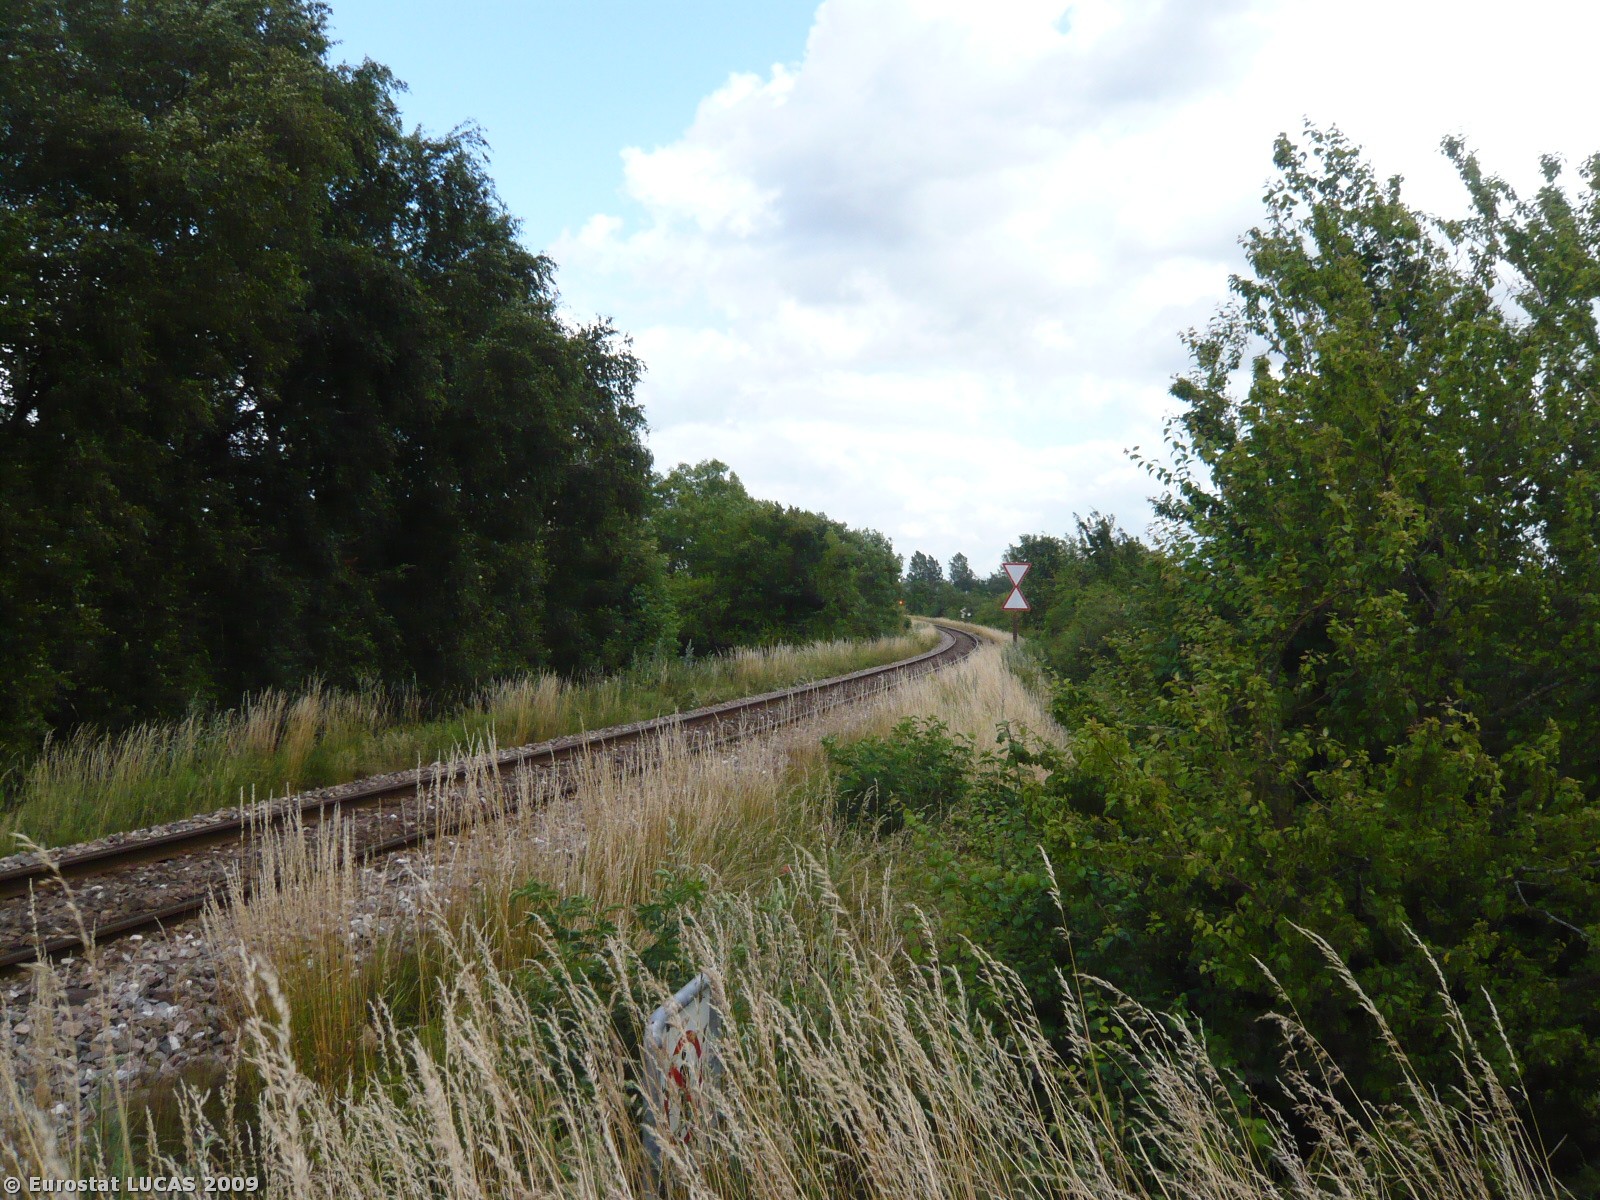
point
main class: Woodland
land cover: Broadleaved woodland
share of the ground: > 75 %
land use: Railway transport
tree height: > 5 m
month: July
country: DK
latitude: 55.5314
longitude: 11.5354
